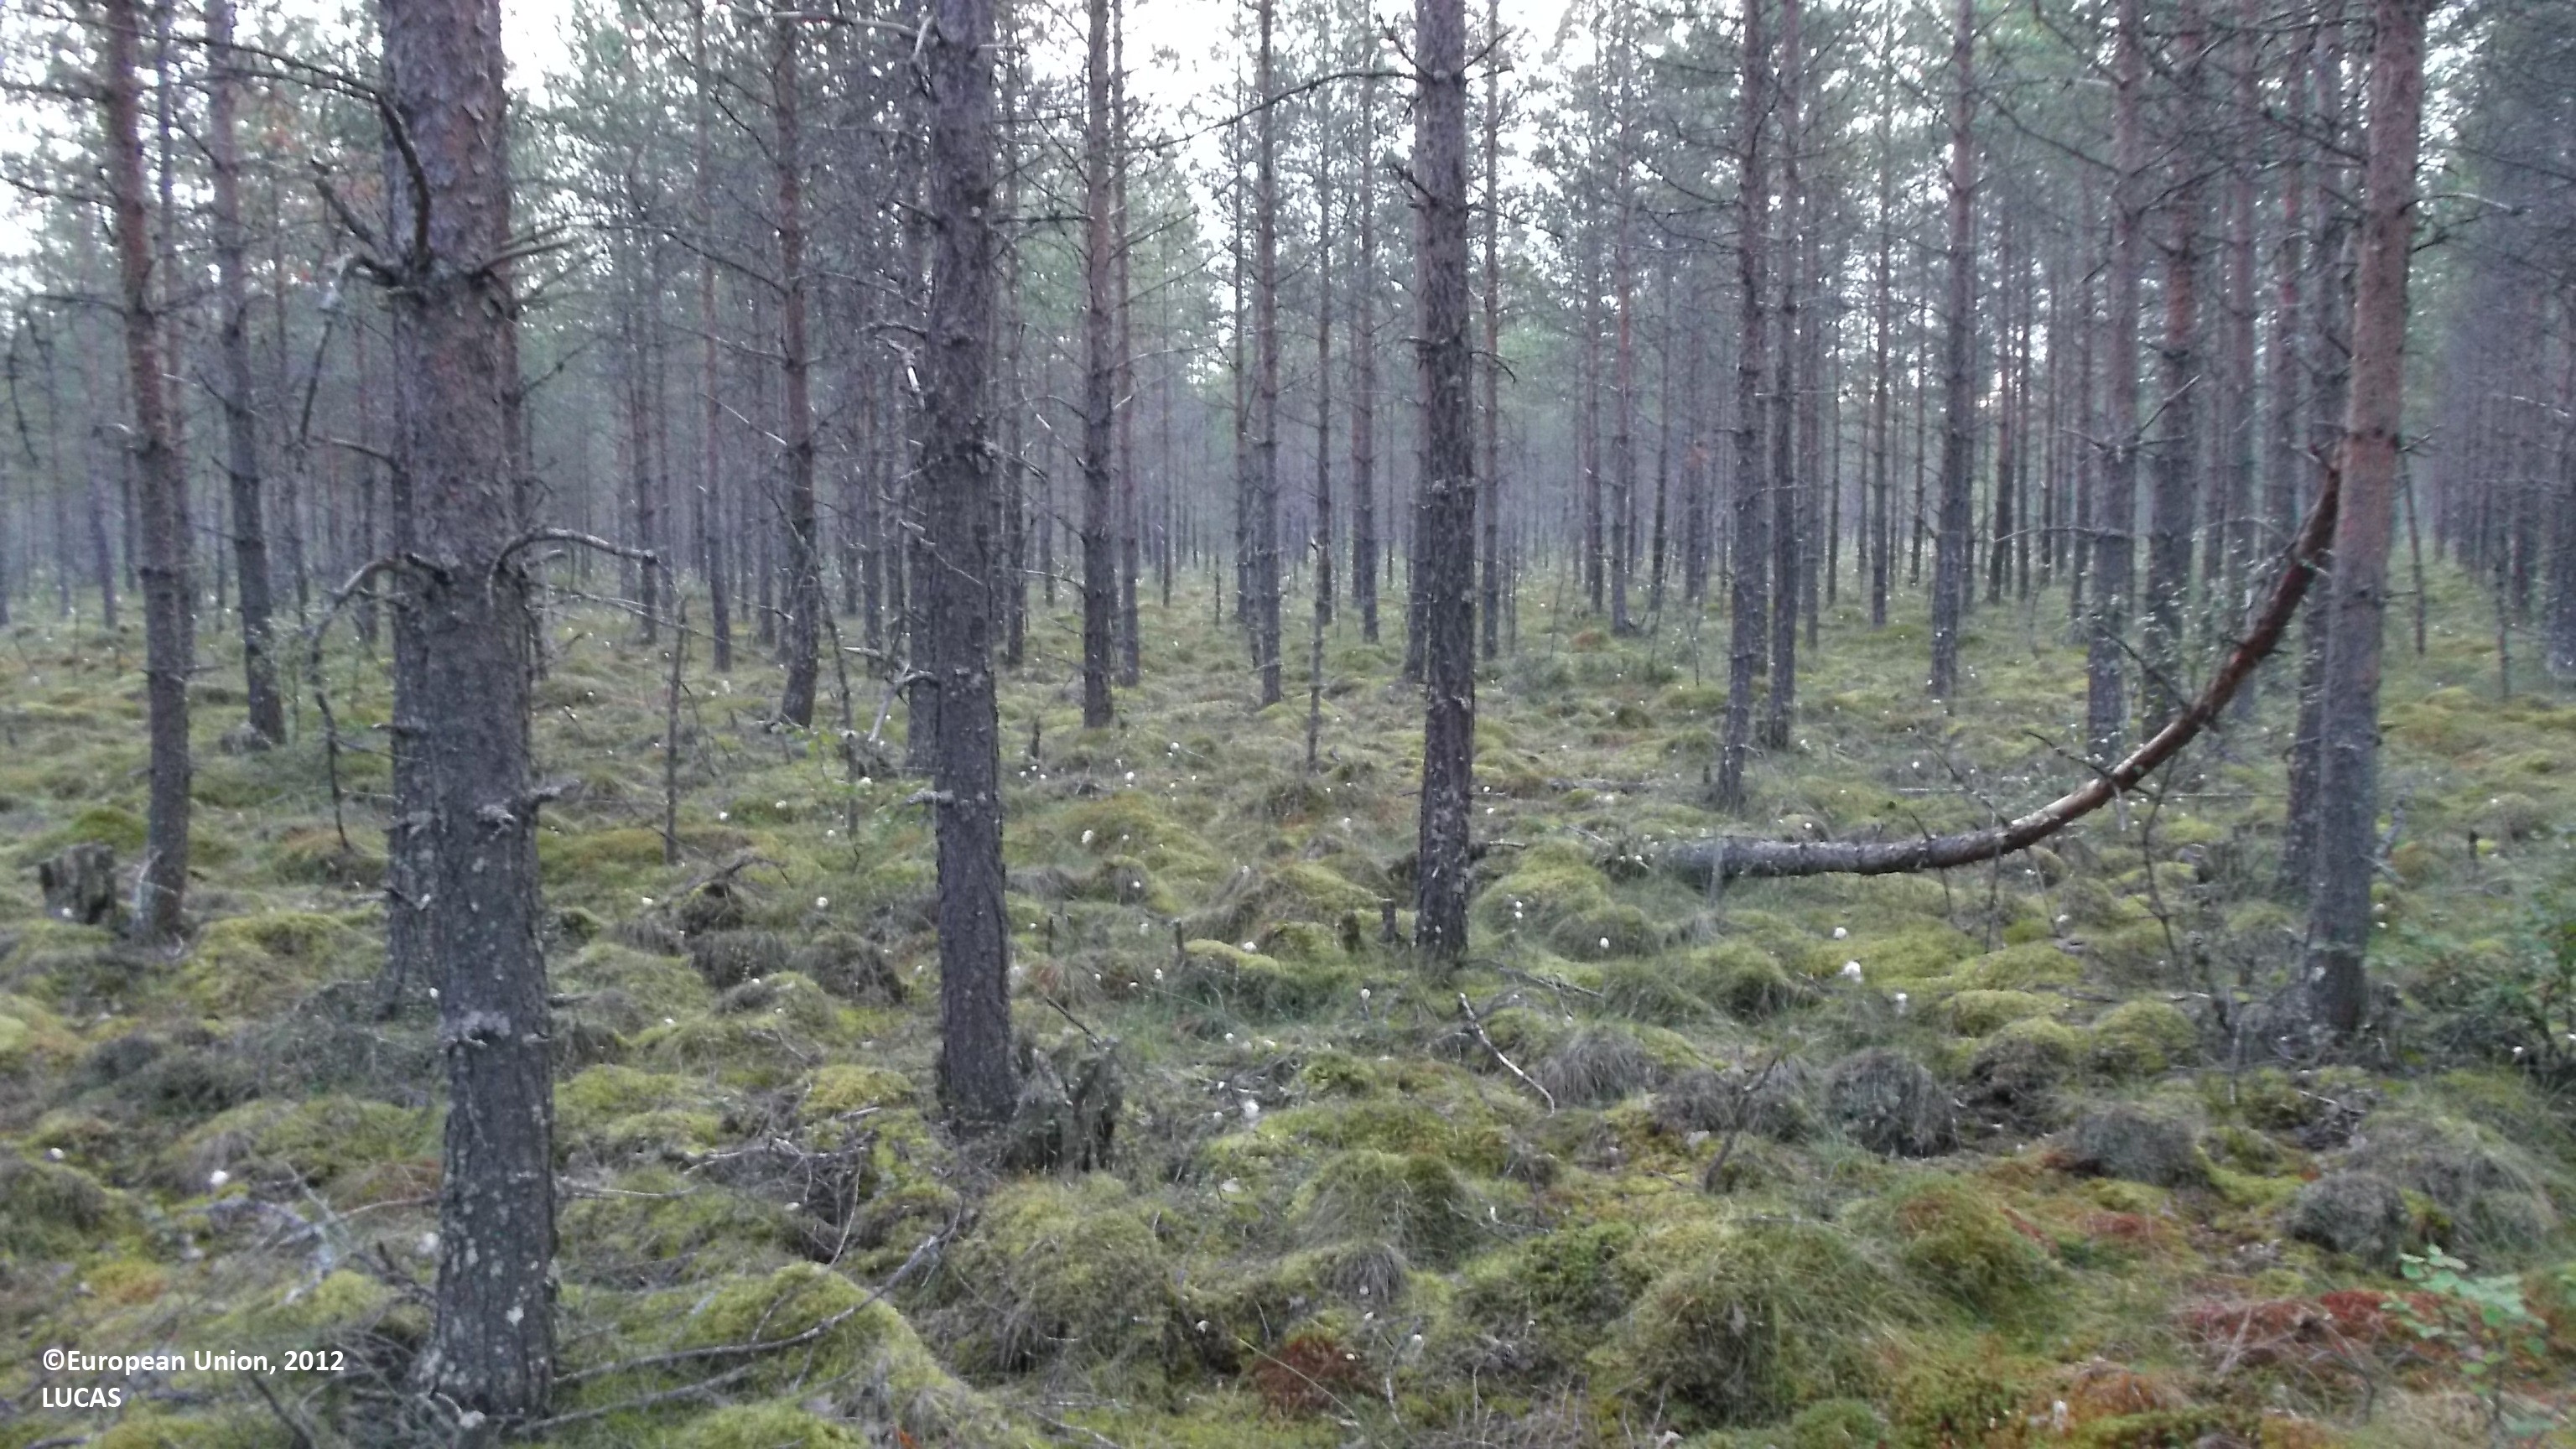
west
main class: Woodland
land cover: Pine dominated coniferous woodland
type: mire and swamp forests
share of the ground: 25 - 50 %
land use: Semi-natural and natural areas not in use
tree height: > 5 m
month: July
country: FI
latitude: 63.3632
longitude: 24.4549
